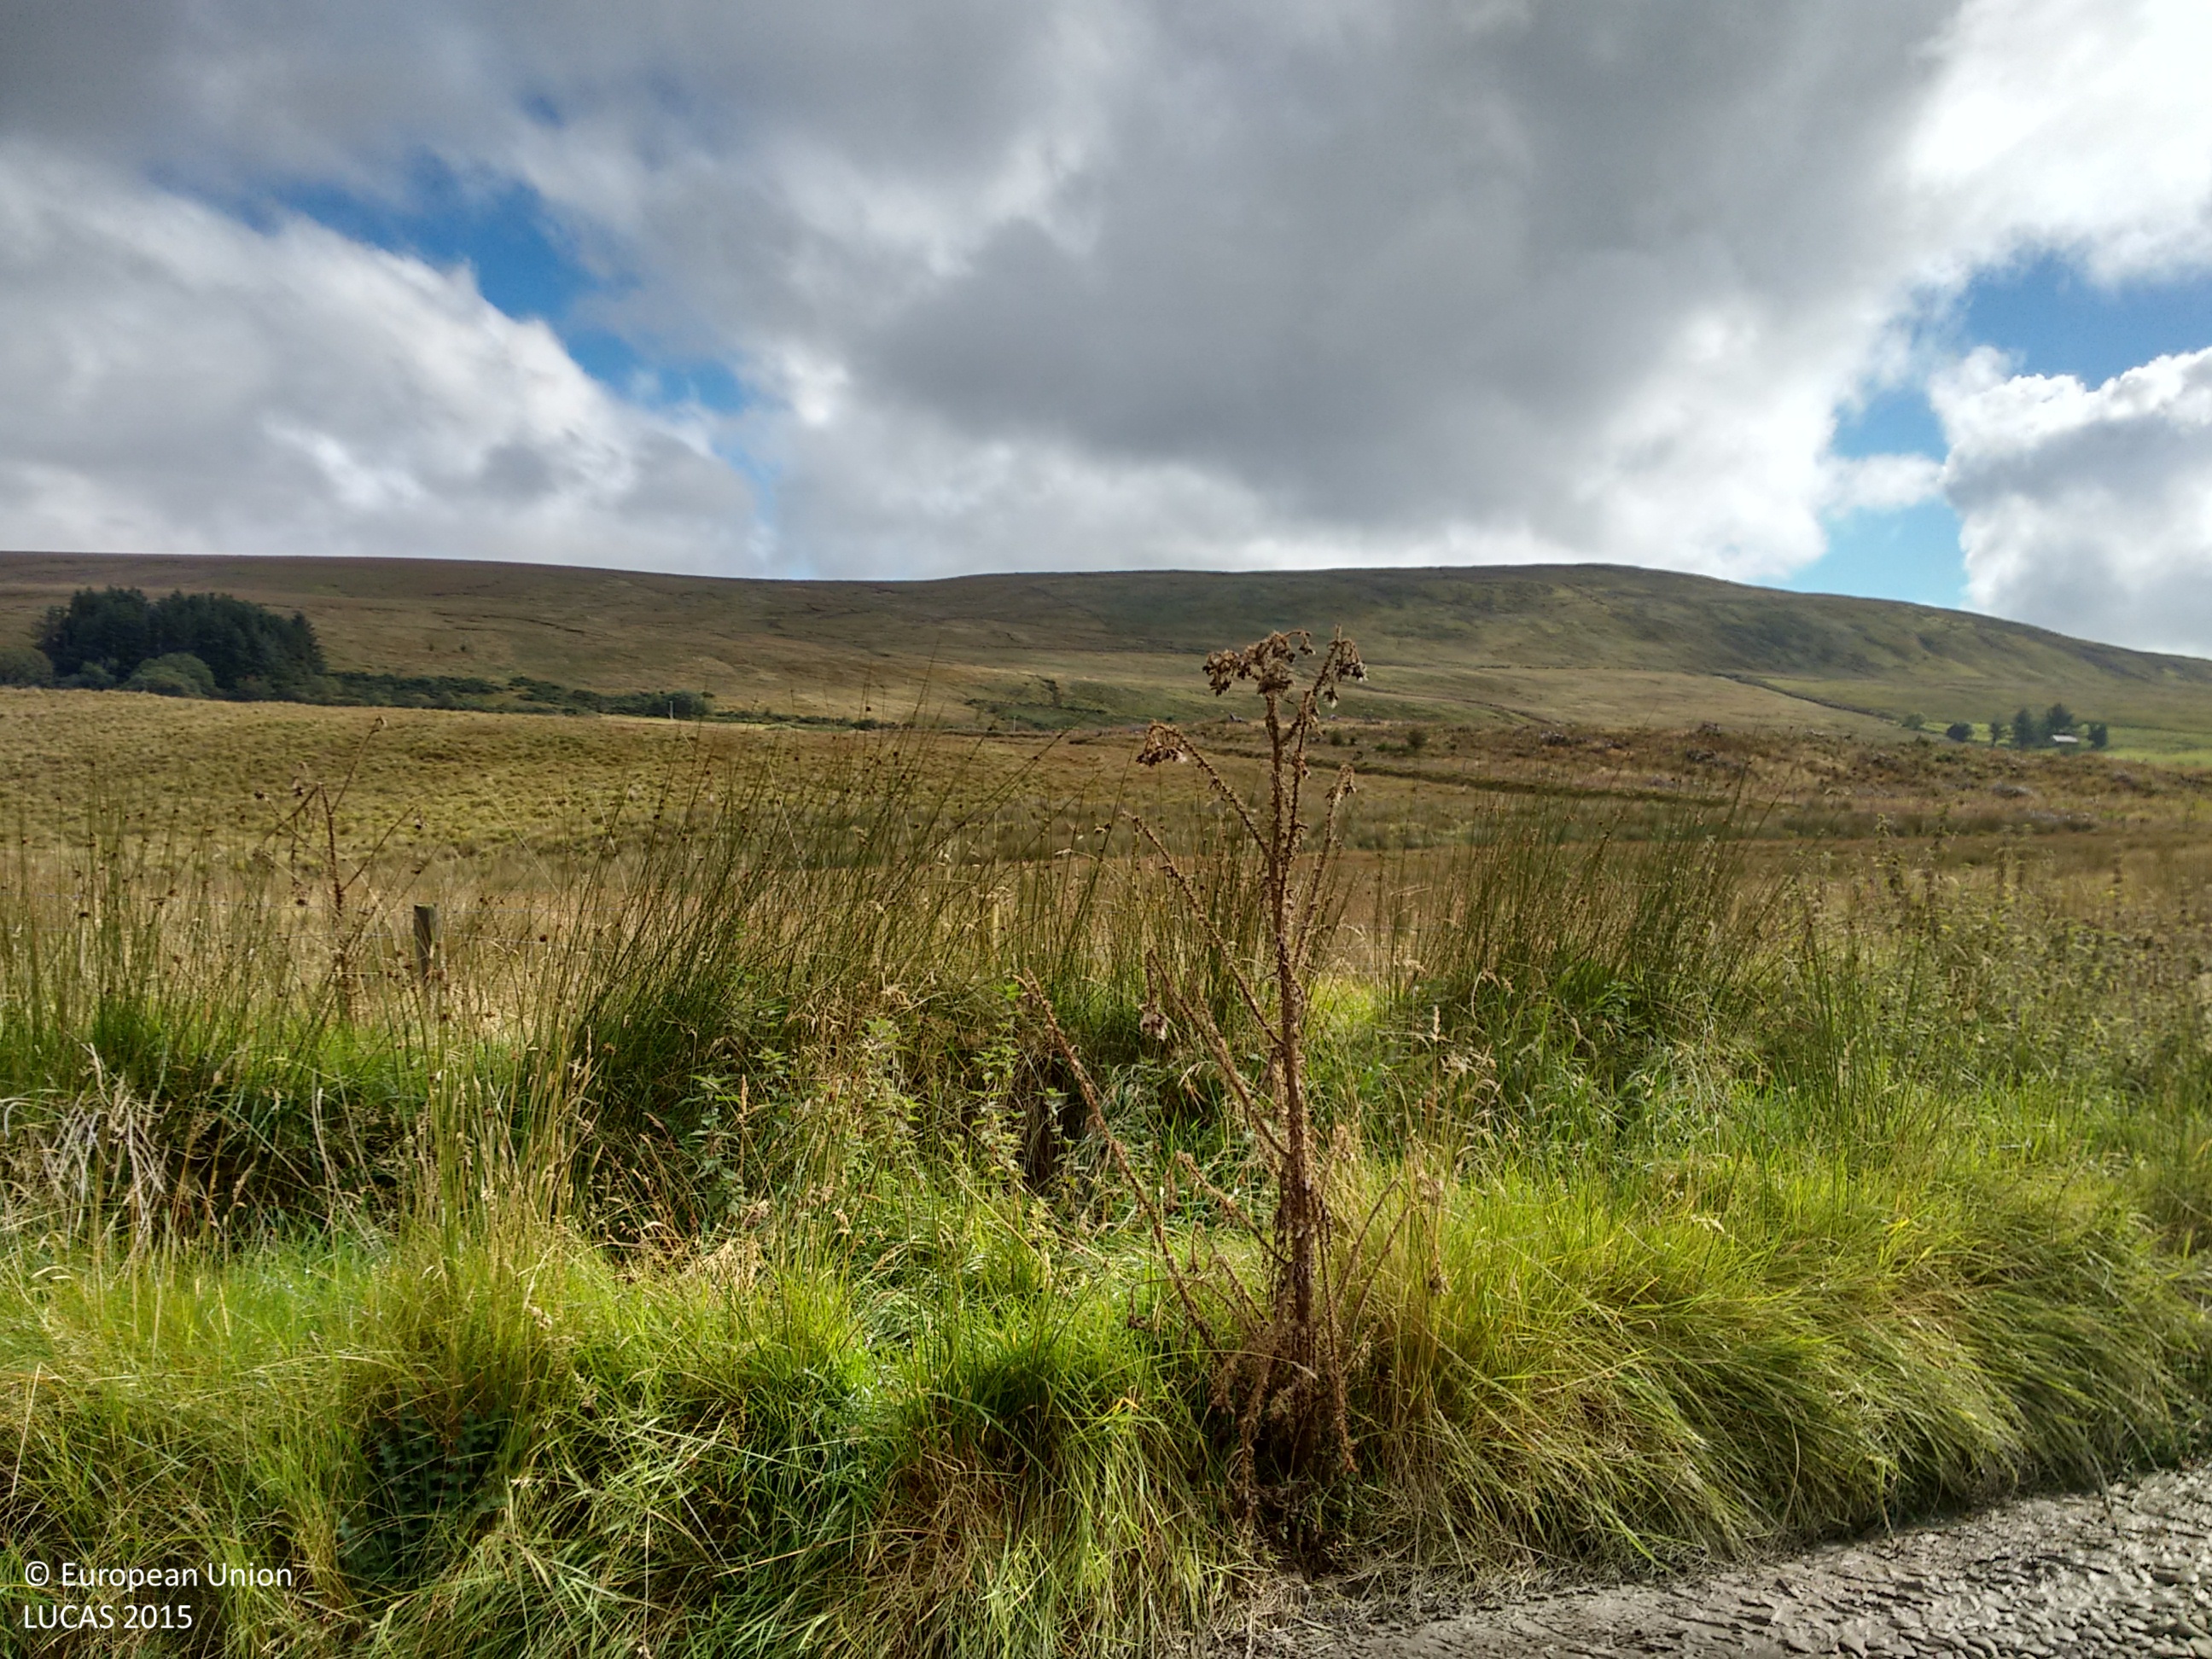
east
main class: Woodland
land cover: Spruce dominated coniferous woodland
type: exotic forest
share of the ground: > 75 %
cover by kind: coniferous forest trees 100 %
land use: Forestry
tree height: > 5 m
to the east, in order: Spruce dominated coniferous woodland; Fences; Grass margins; Tracks; Grass margins; Ditches and canals; Fences; Grassland without tree/shrub cover
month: September
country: IE
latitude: 55.1726
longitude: -7.2428
